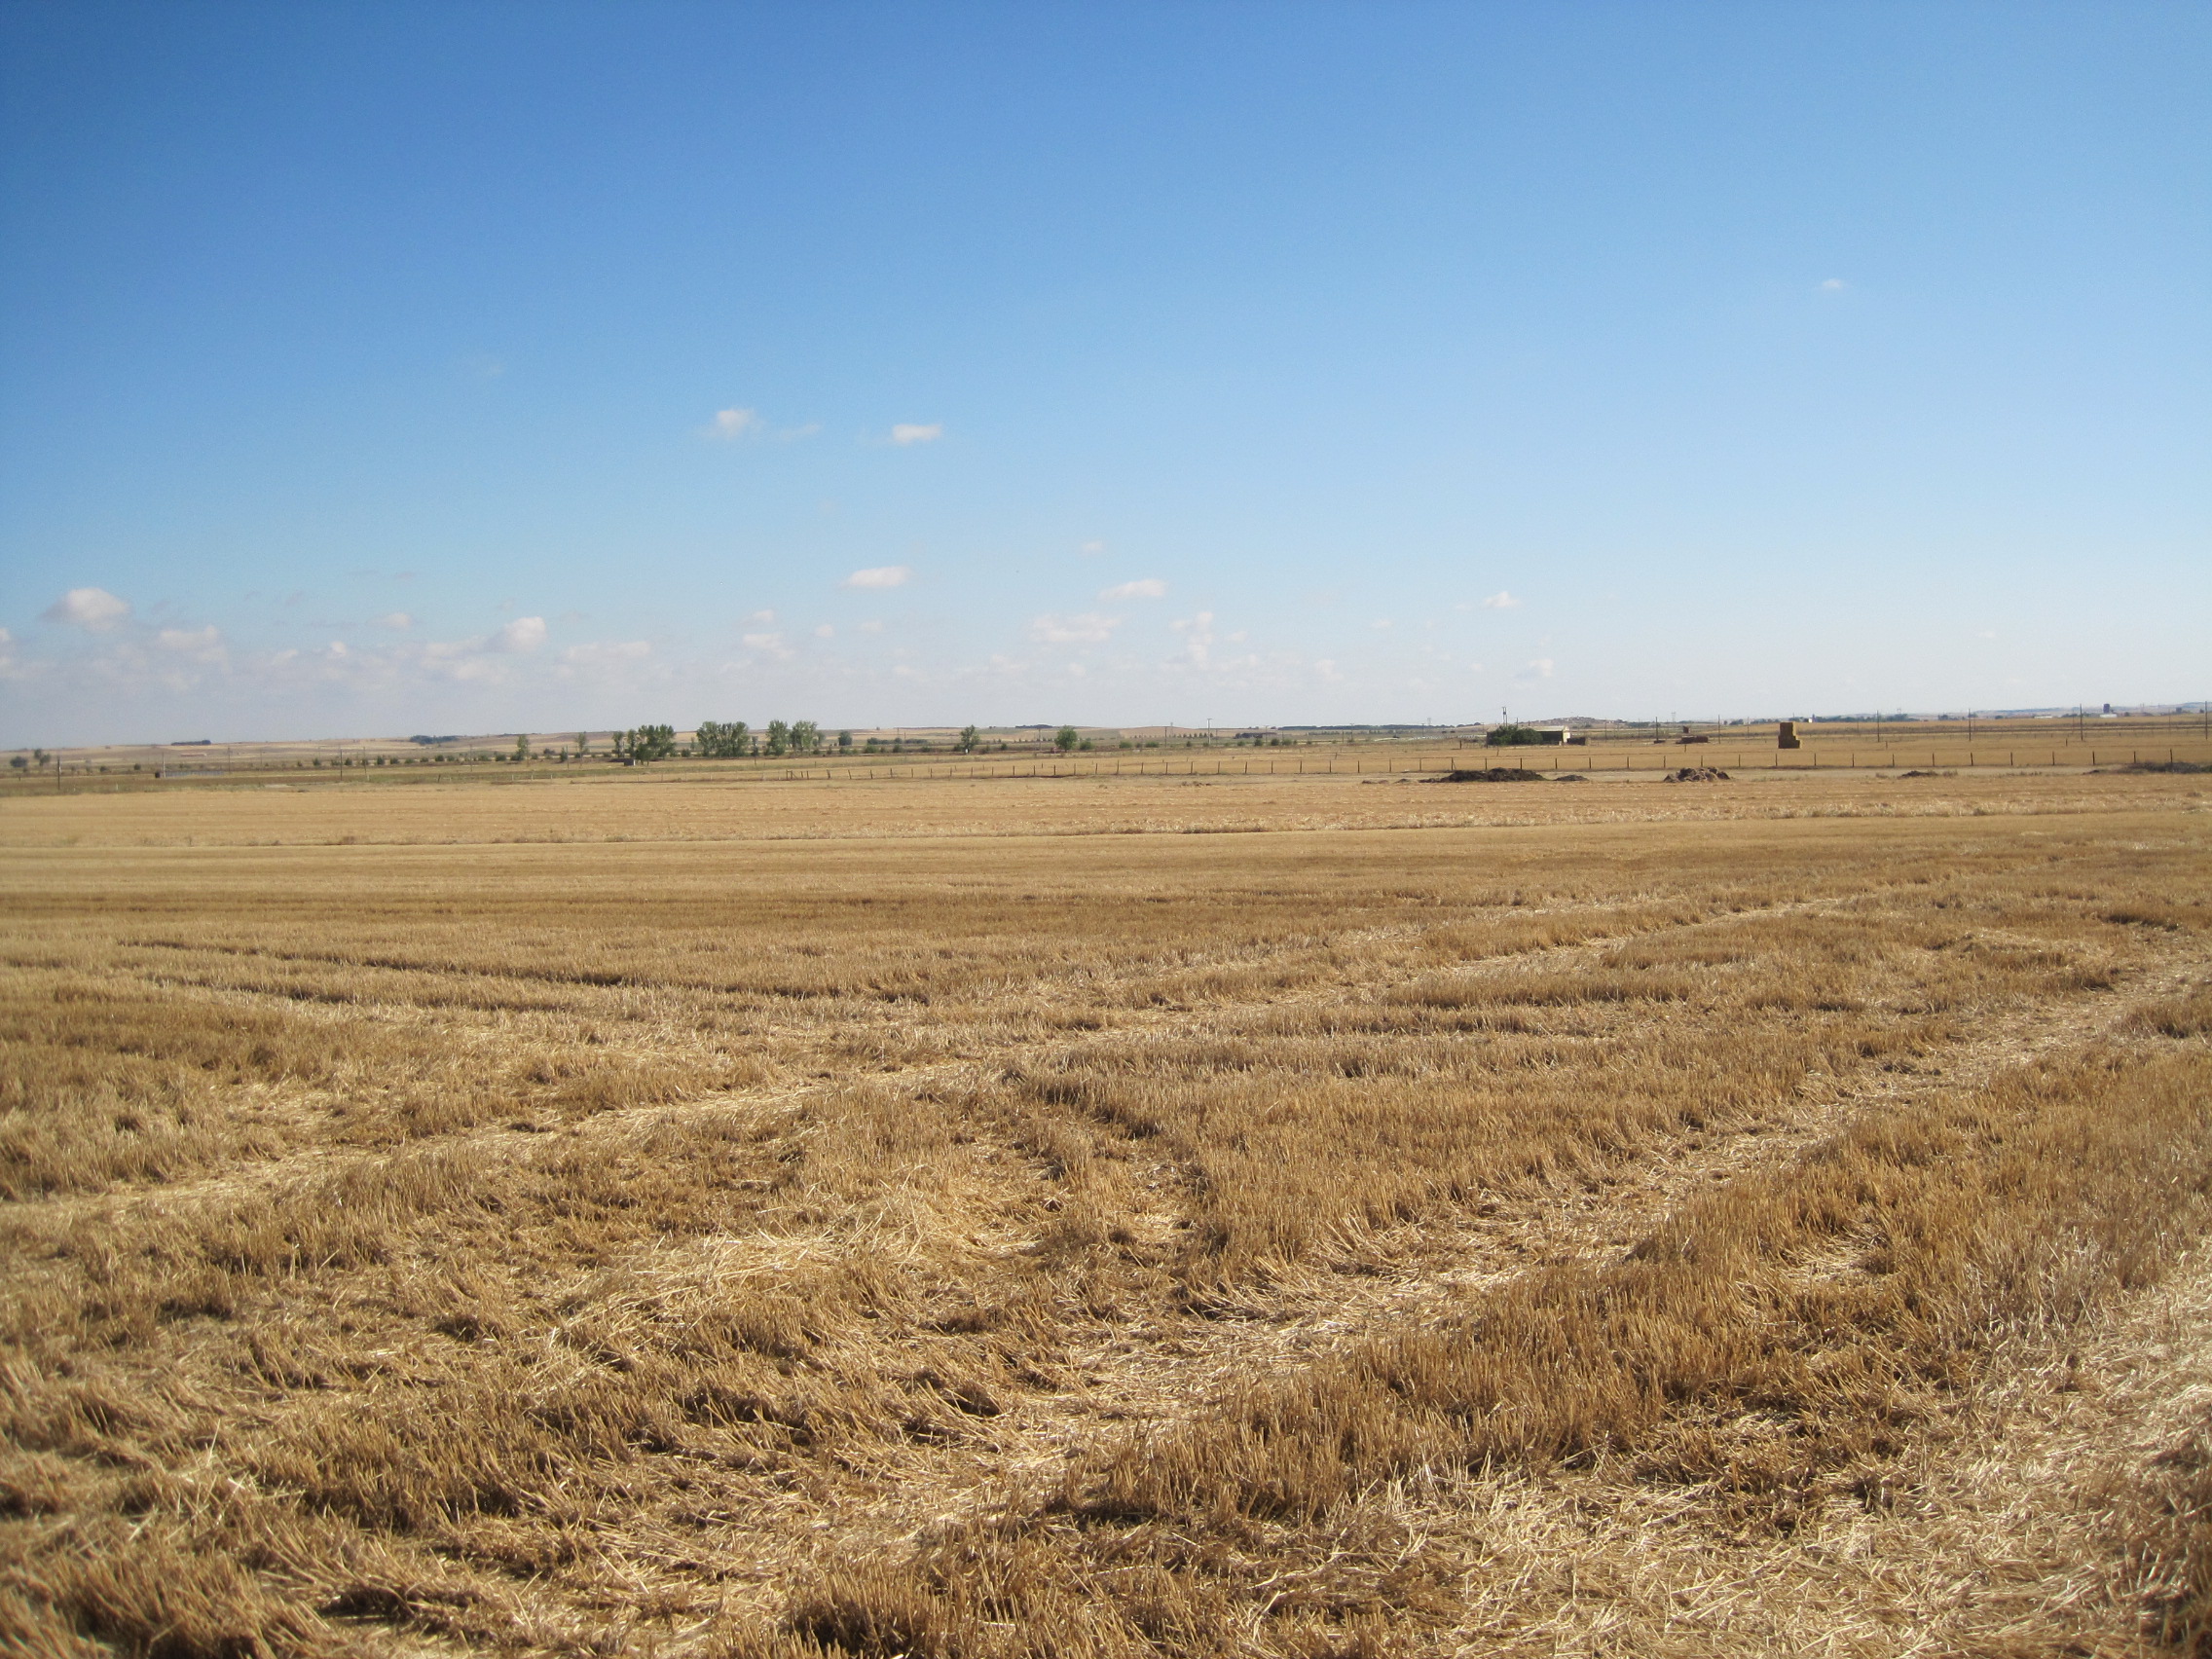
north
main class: Cropland
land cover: Barley
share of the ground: < 10 %
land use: Agriculture (excluding fallow land and kitchen gardens)
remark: Harvested field
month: July
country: ES
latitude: 41.8721
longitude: -5.3983
